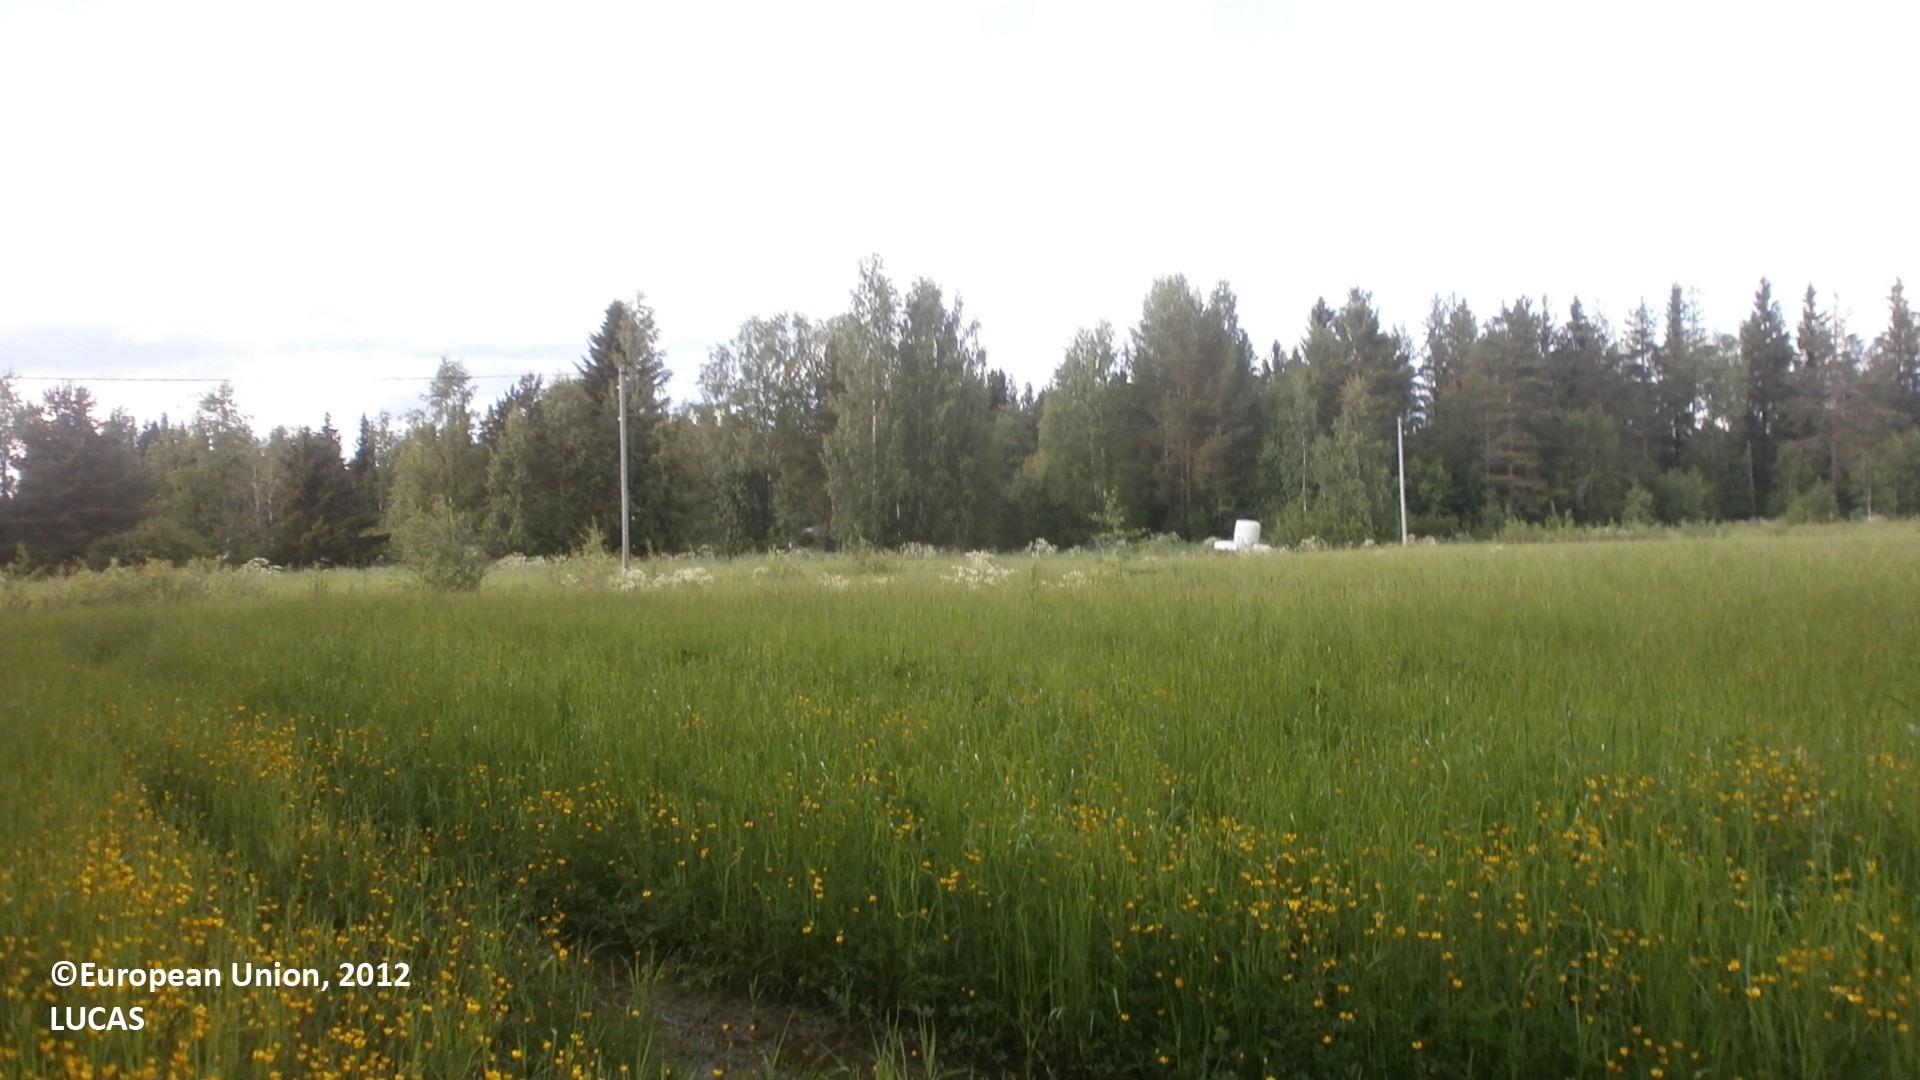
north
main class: Grassland
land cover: Grassland without tree/shrub cover
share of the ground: > 75 %
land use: Agriculture (excluding fallow land and kitchen gardens)
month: June
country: FI
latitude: 64.2303
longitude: 25.0291
